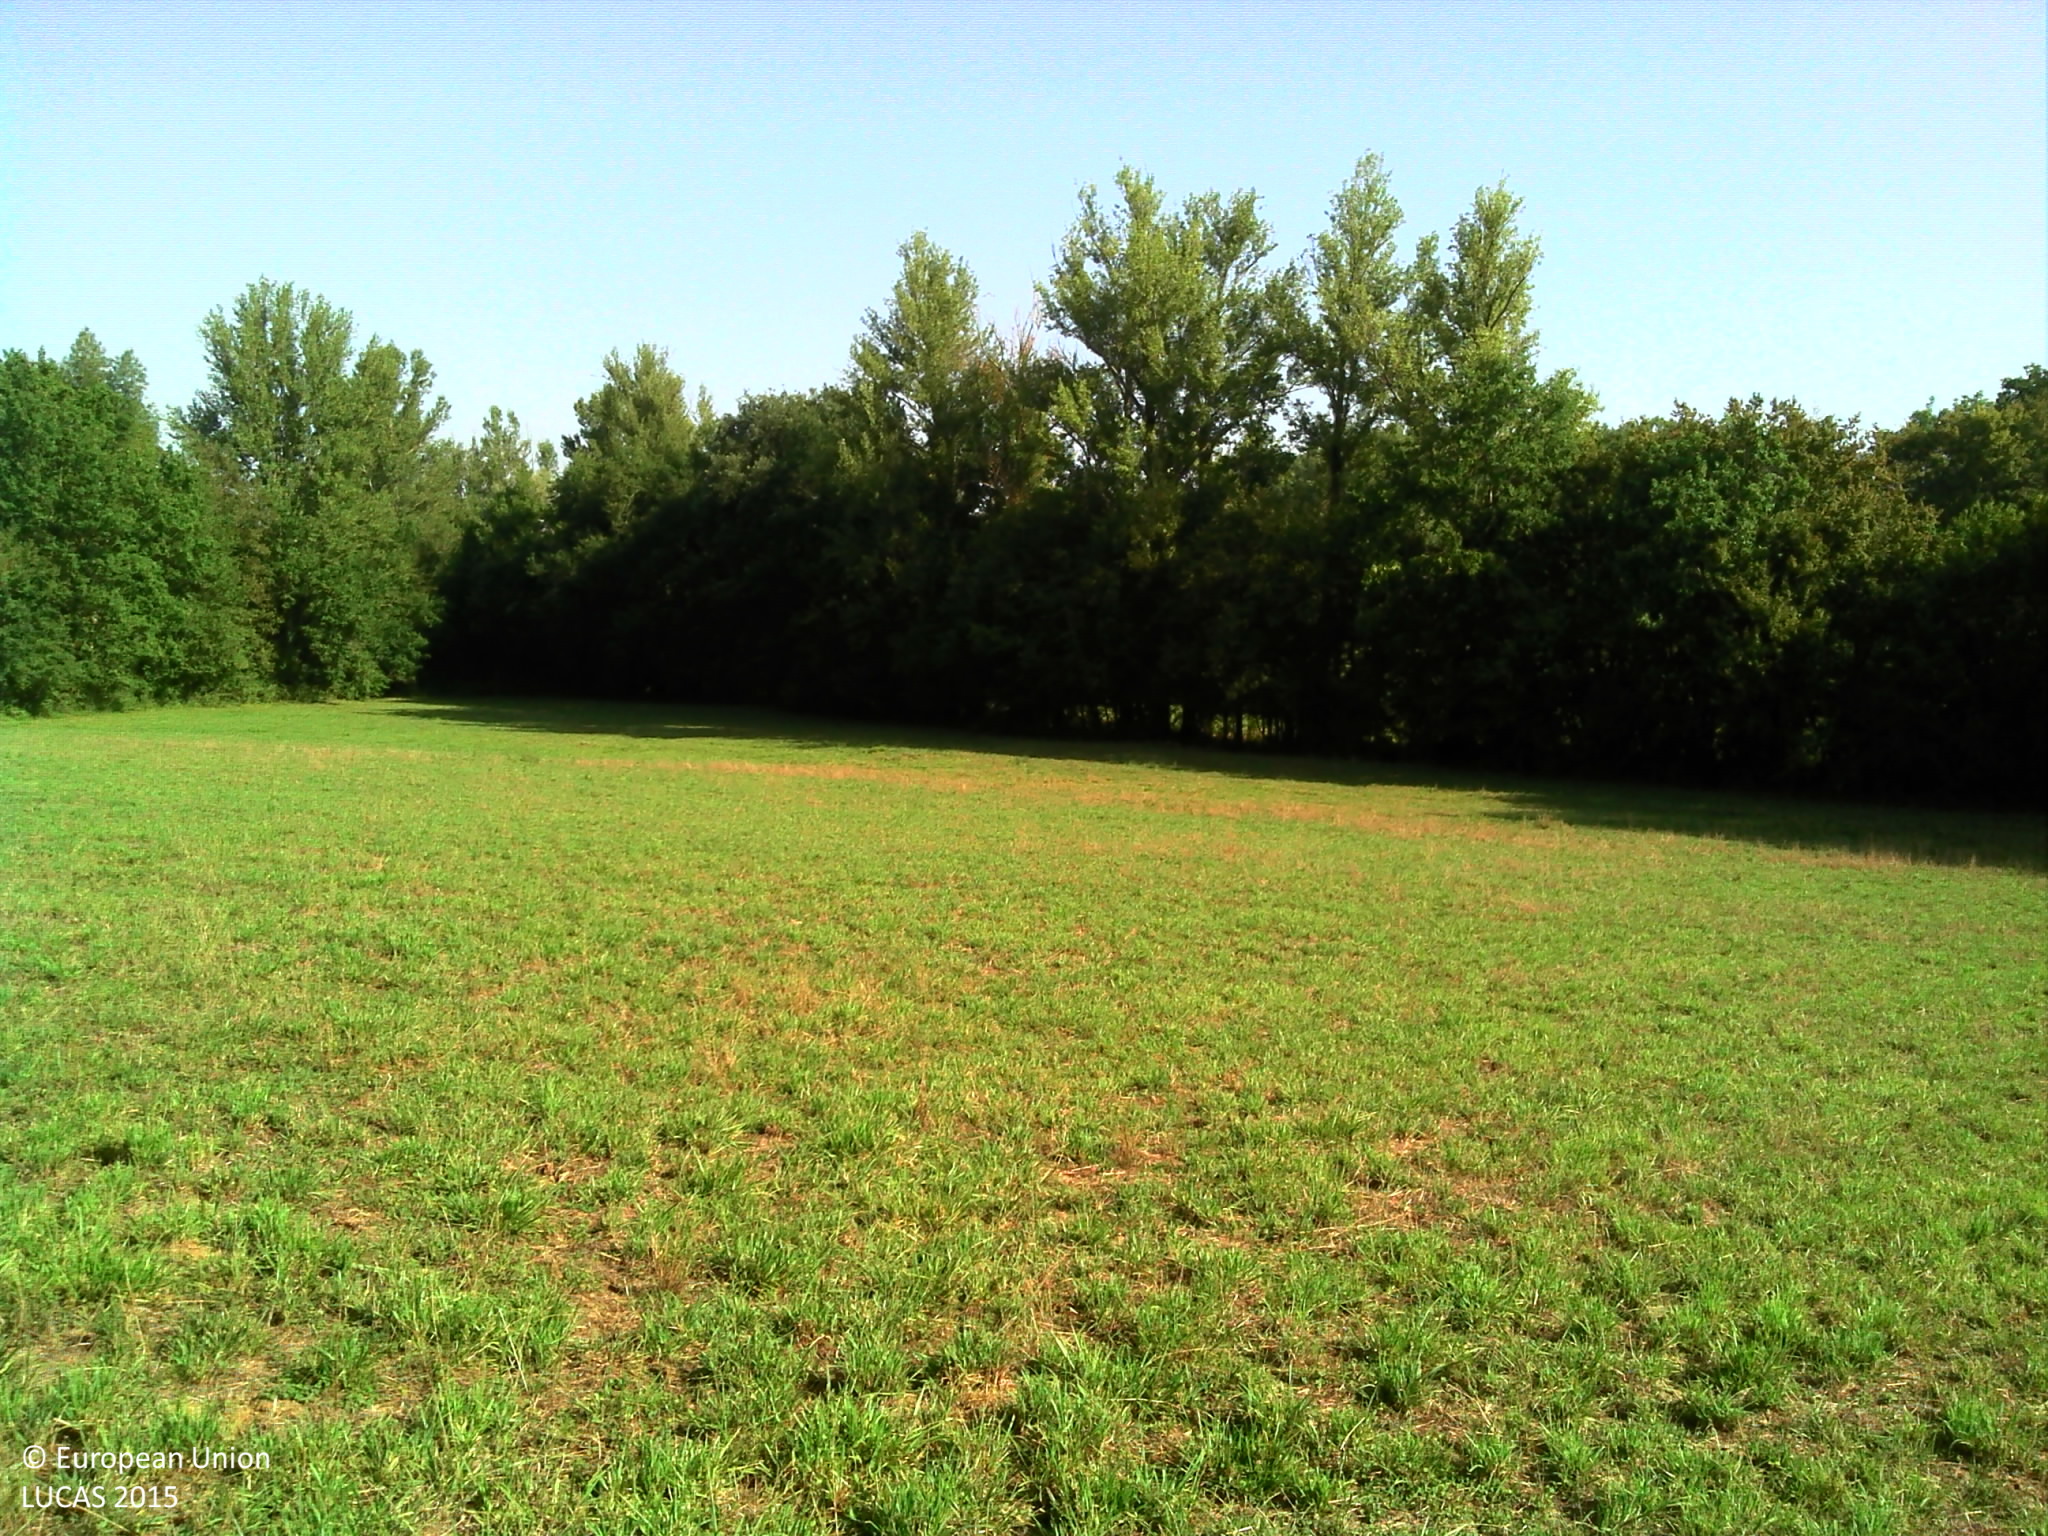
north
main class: Grassland
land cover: Grassland without tree/shrub cover
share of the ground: > 75 %
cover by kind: herbaceous plants 100 %
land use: Agriculture (excluding fallow land and kitchen gardens)
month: August
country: FR
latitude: 44.1294
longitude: 1.5139
